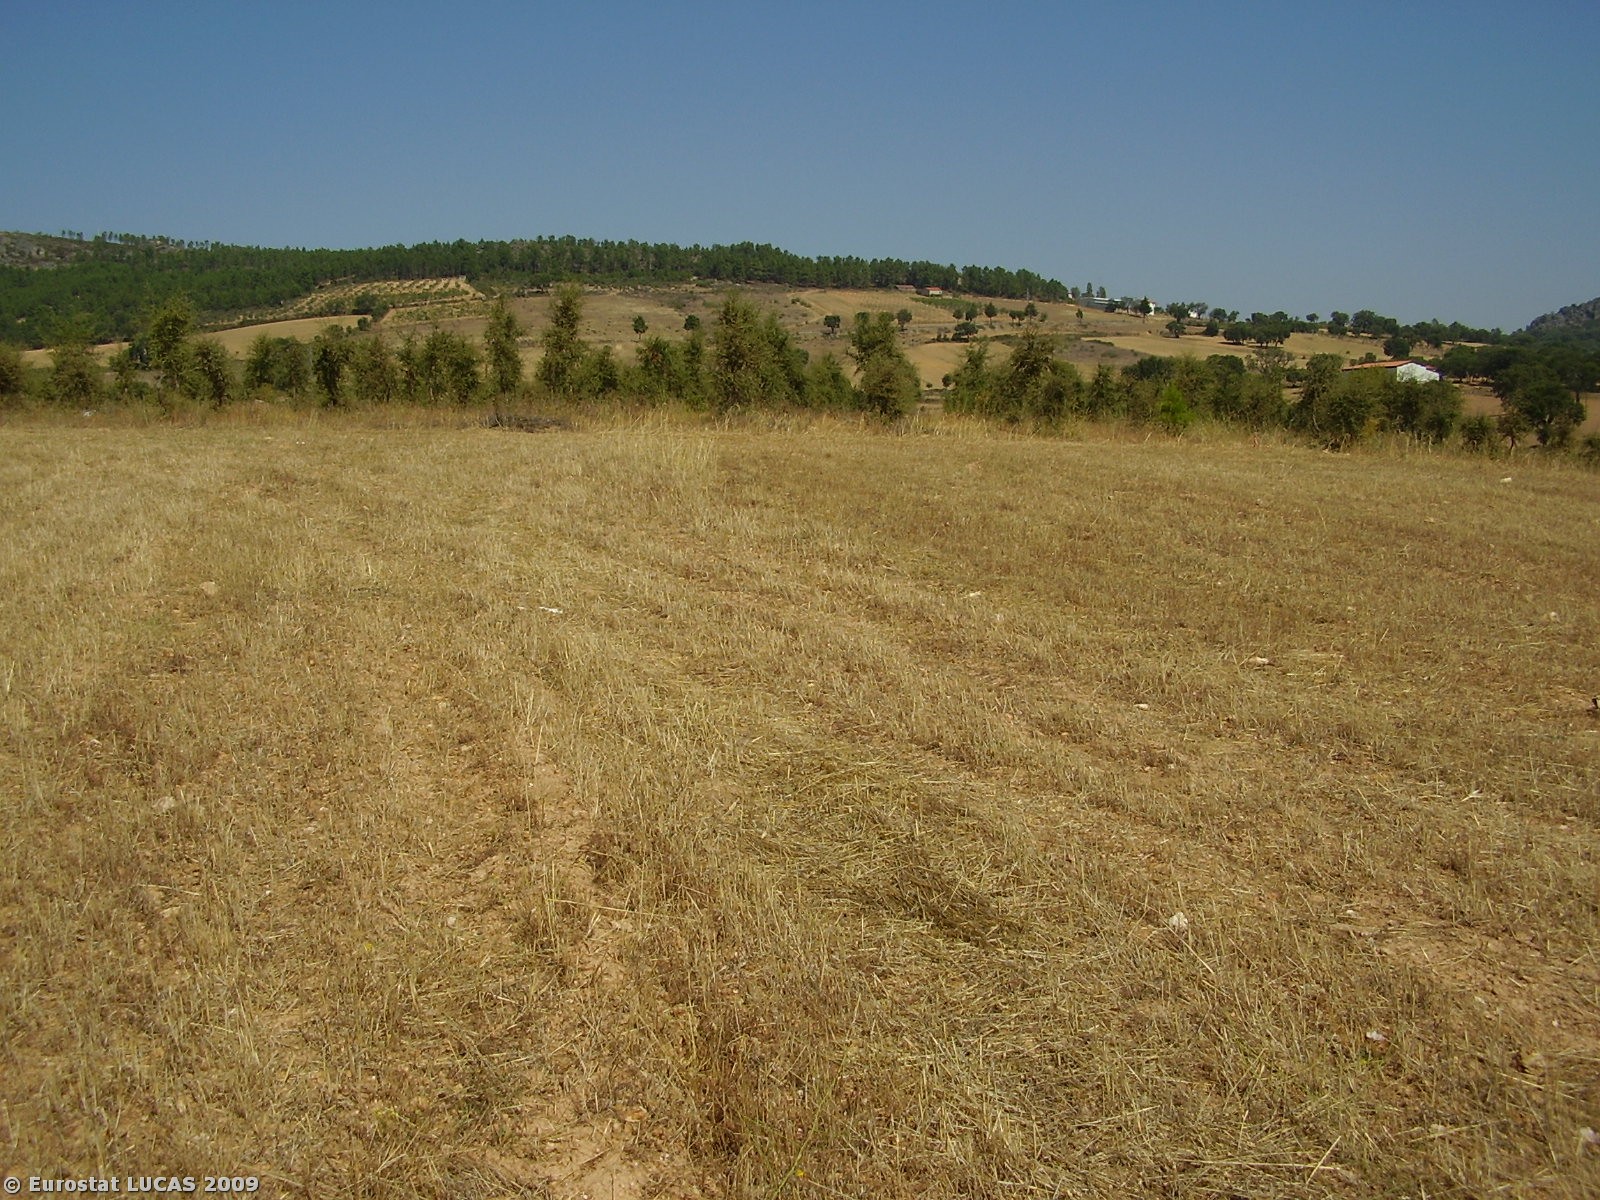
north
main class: Cropland
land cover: Common wheat
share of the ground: < 10 %
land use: Agriculture (excluding fallow land and kitchen gardens)
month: August
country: PT
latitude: 41.3079
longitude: -6.7194
